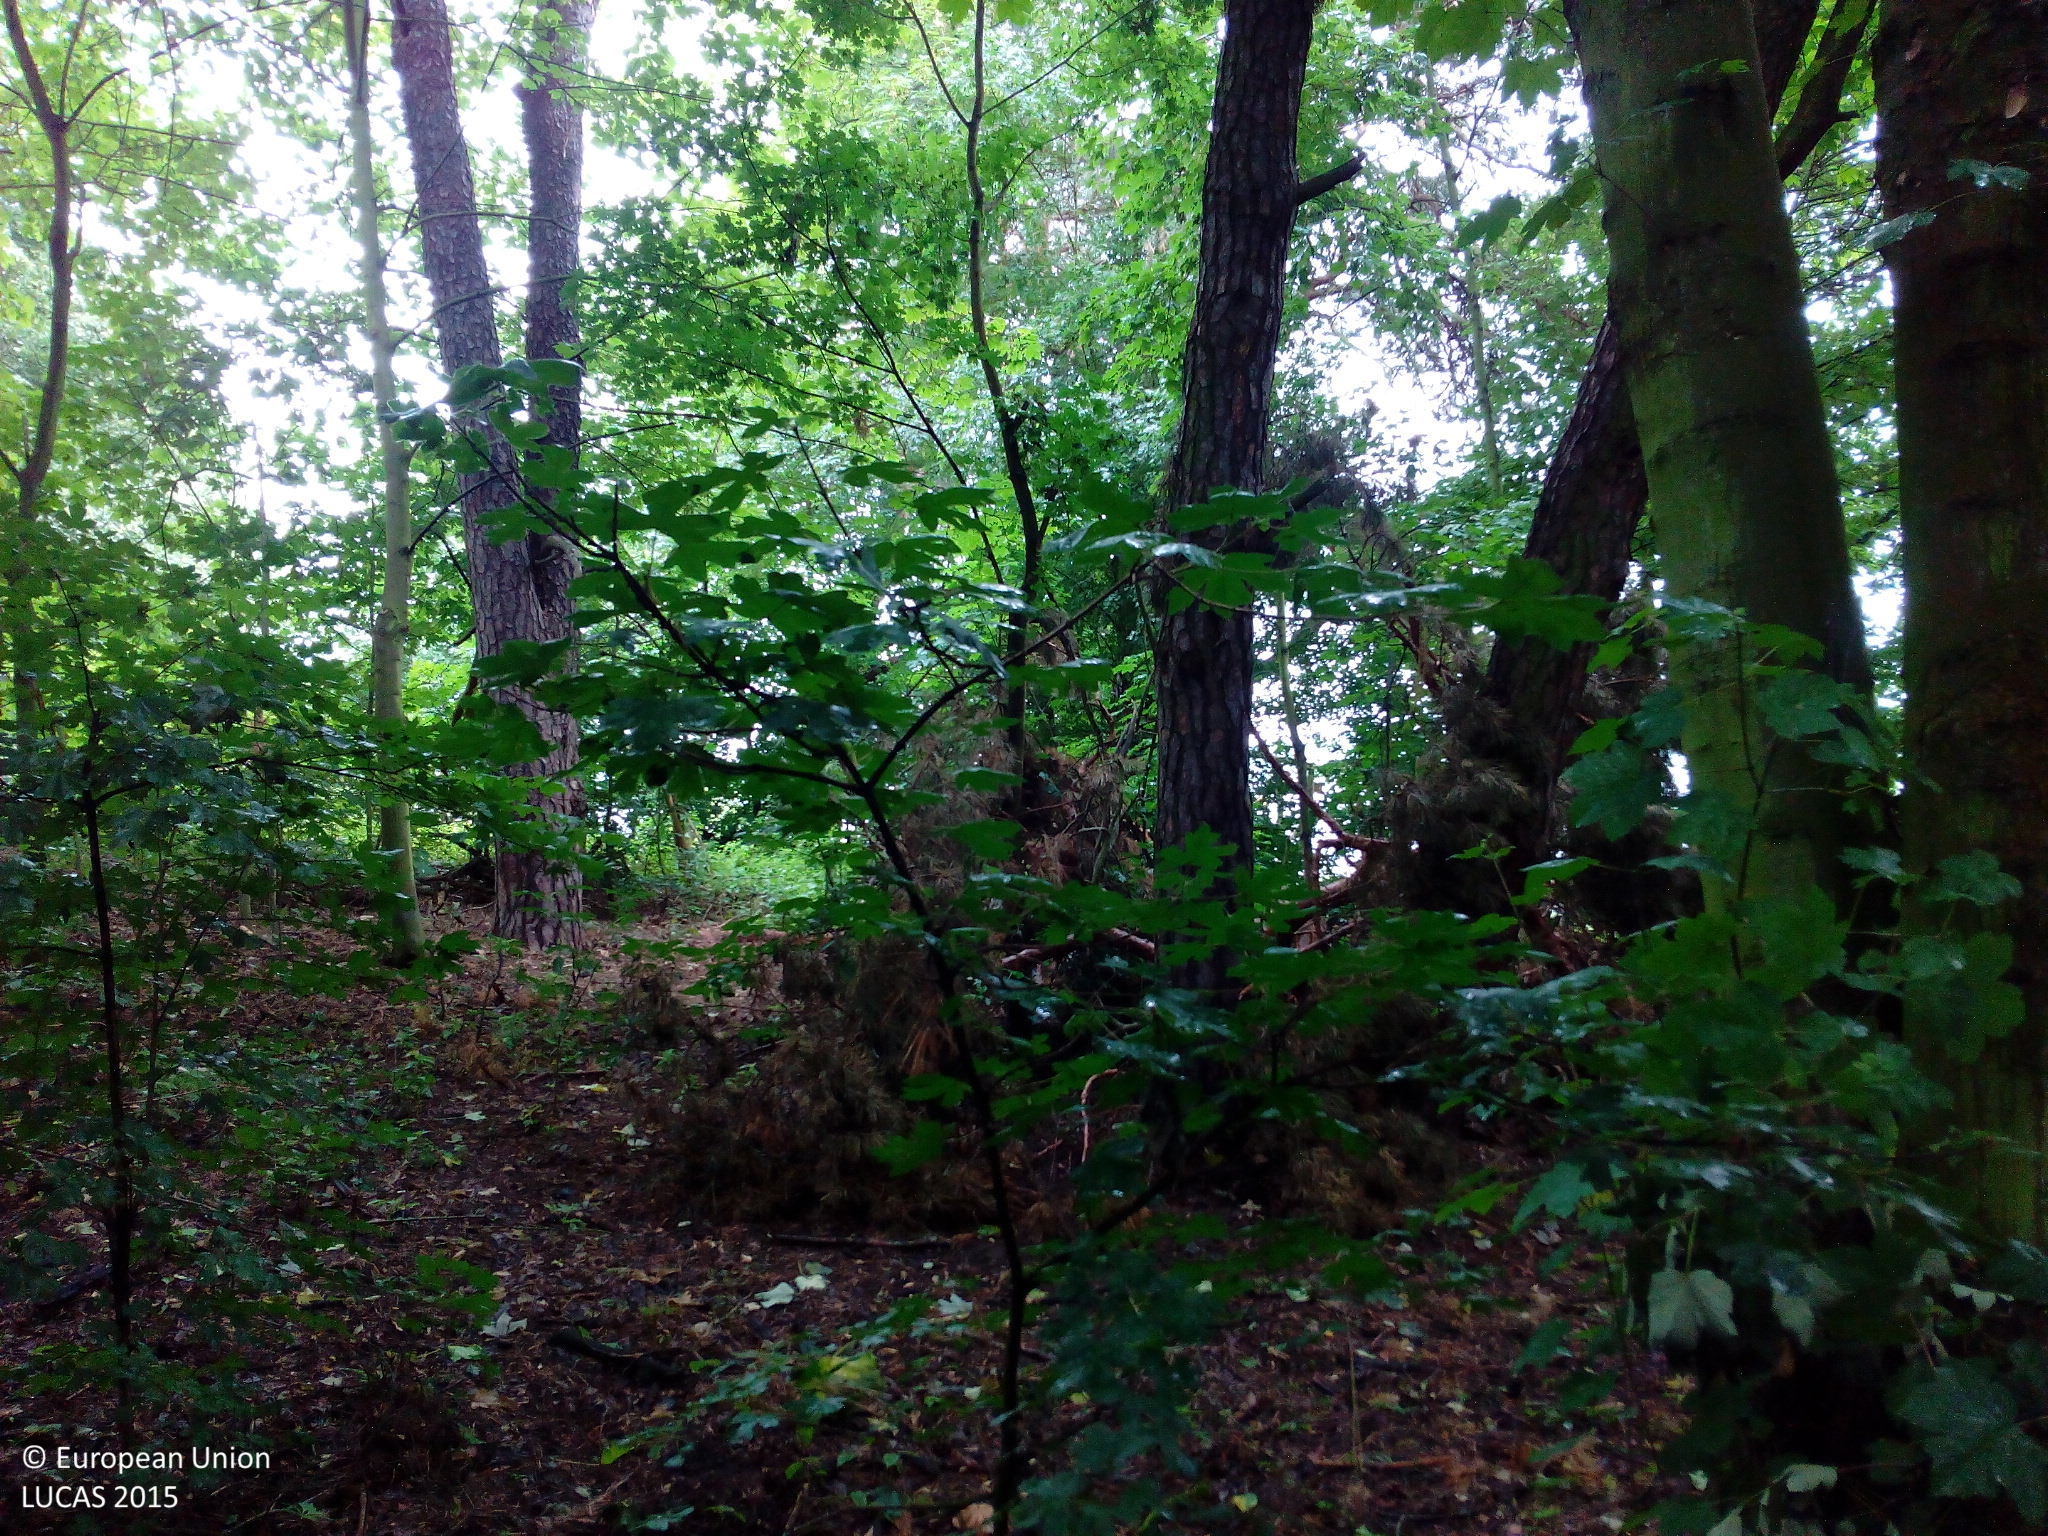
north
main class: Woodland
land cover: Broadleaved woodland
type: mesophytic deciduous forest
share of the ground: > 75 %
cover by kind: broadleaved forest trees 100 %
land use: Forestry
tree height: > 5 m
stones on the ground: < 10 %
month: July
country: DE
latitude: 52.4964
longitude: 13.1963
